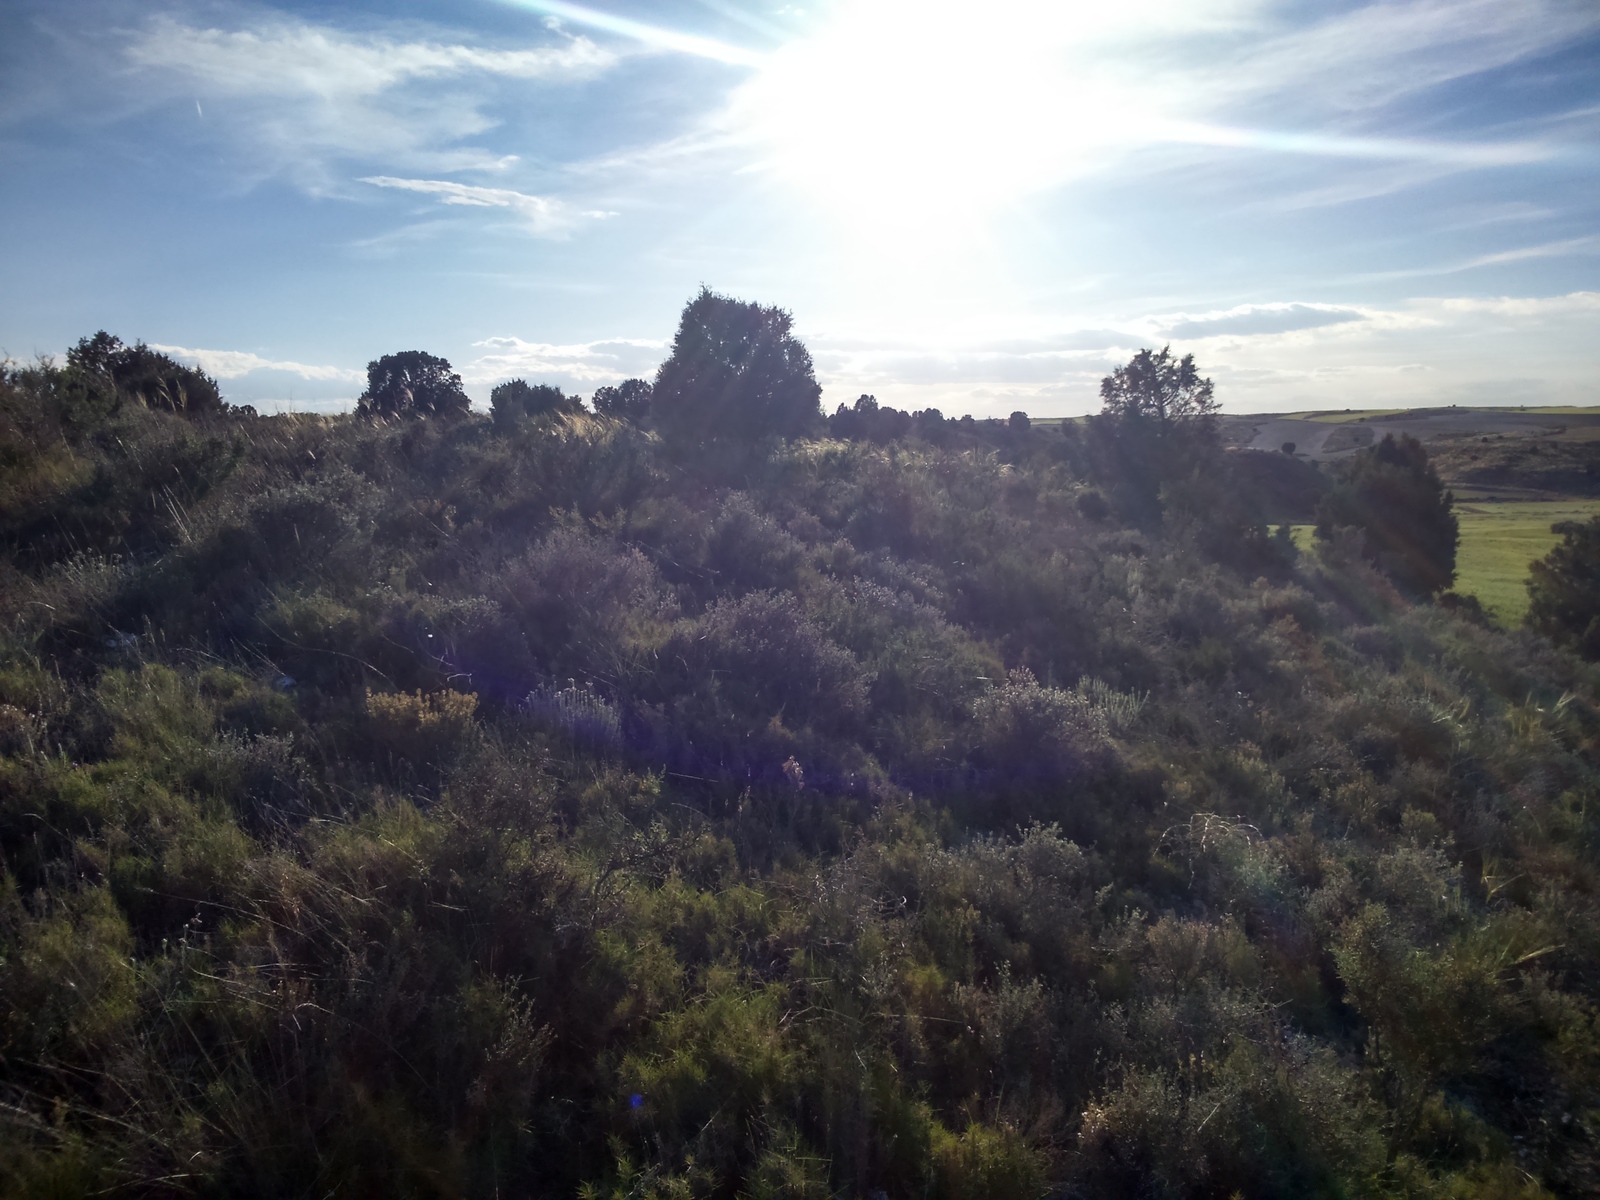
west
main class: Shrubland
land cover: Shrubland with sparse tree cover
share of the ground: > 75 %
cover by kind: shrubs 80 %, herbaceous plants 15 %, coniferous forest trees 5 %
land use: Semi-natural and natural areas not in use
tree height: < 5 m
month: April
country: ES
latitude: 41.4340
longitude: -0.3198
